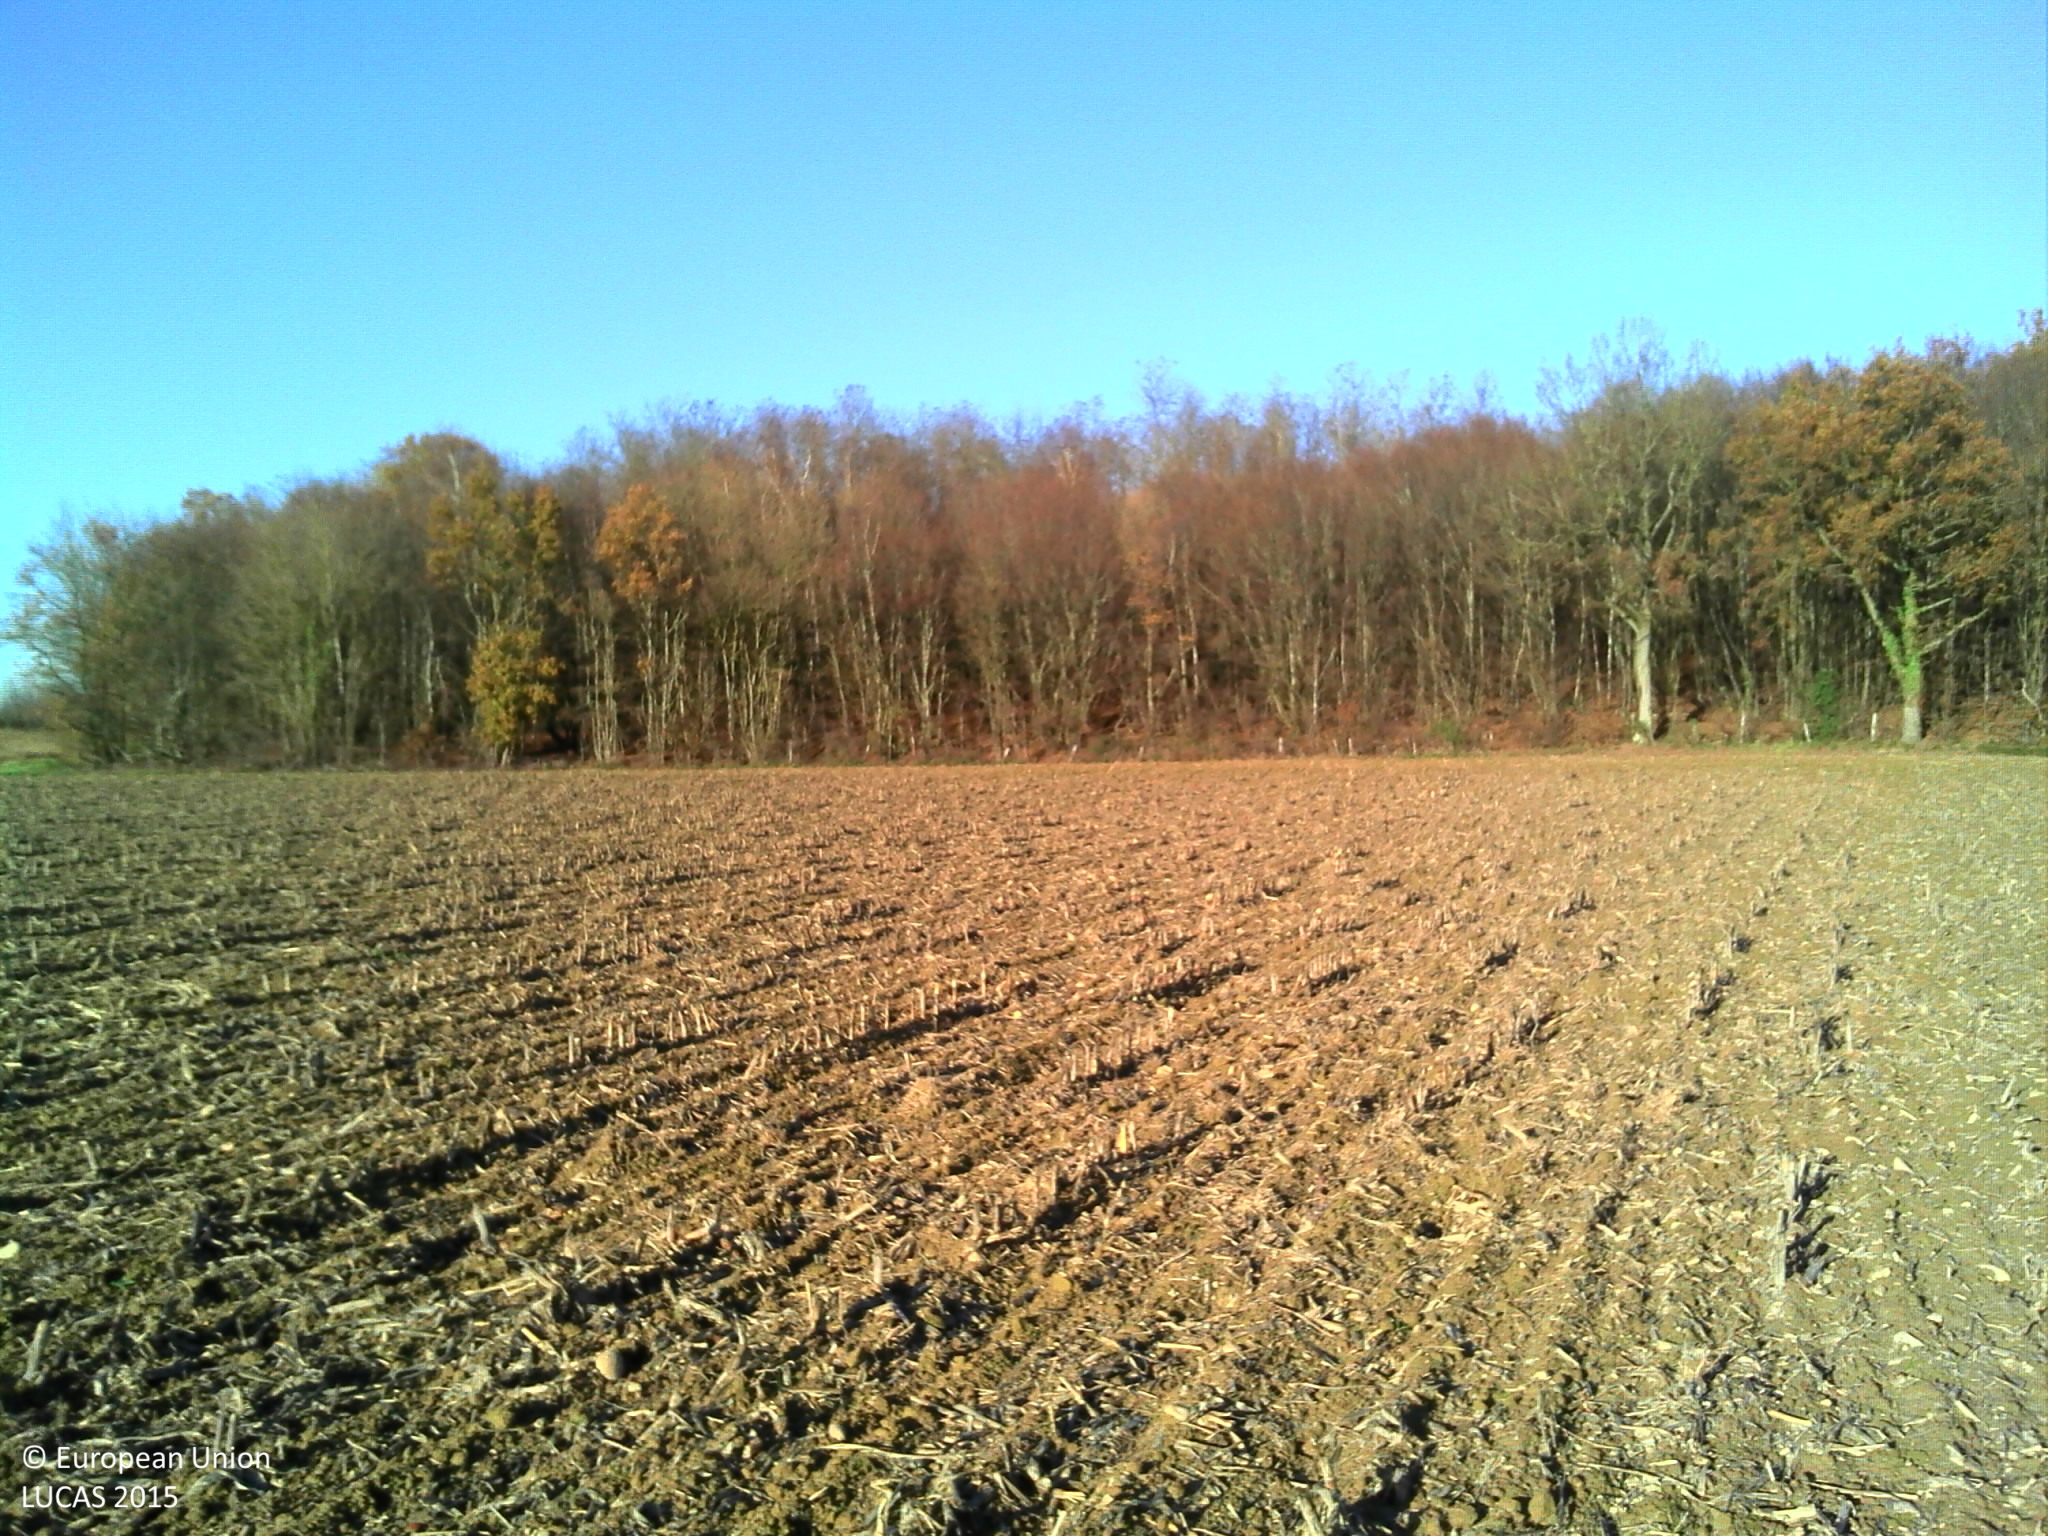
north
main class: Cropland
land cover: Maize
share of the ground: > 75 %
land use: Agriculture (excluding fallow land and kitchen gardens)
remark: Harvested field
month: December
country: FR
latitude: 46.0347
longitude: 4.9770
